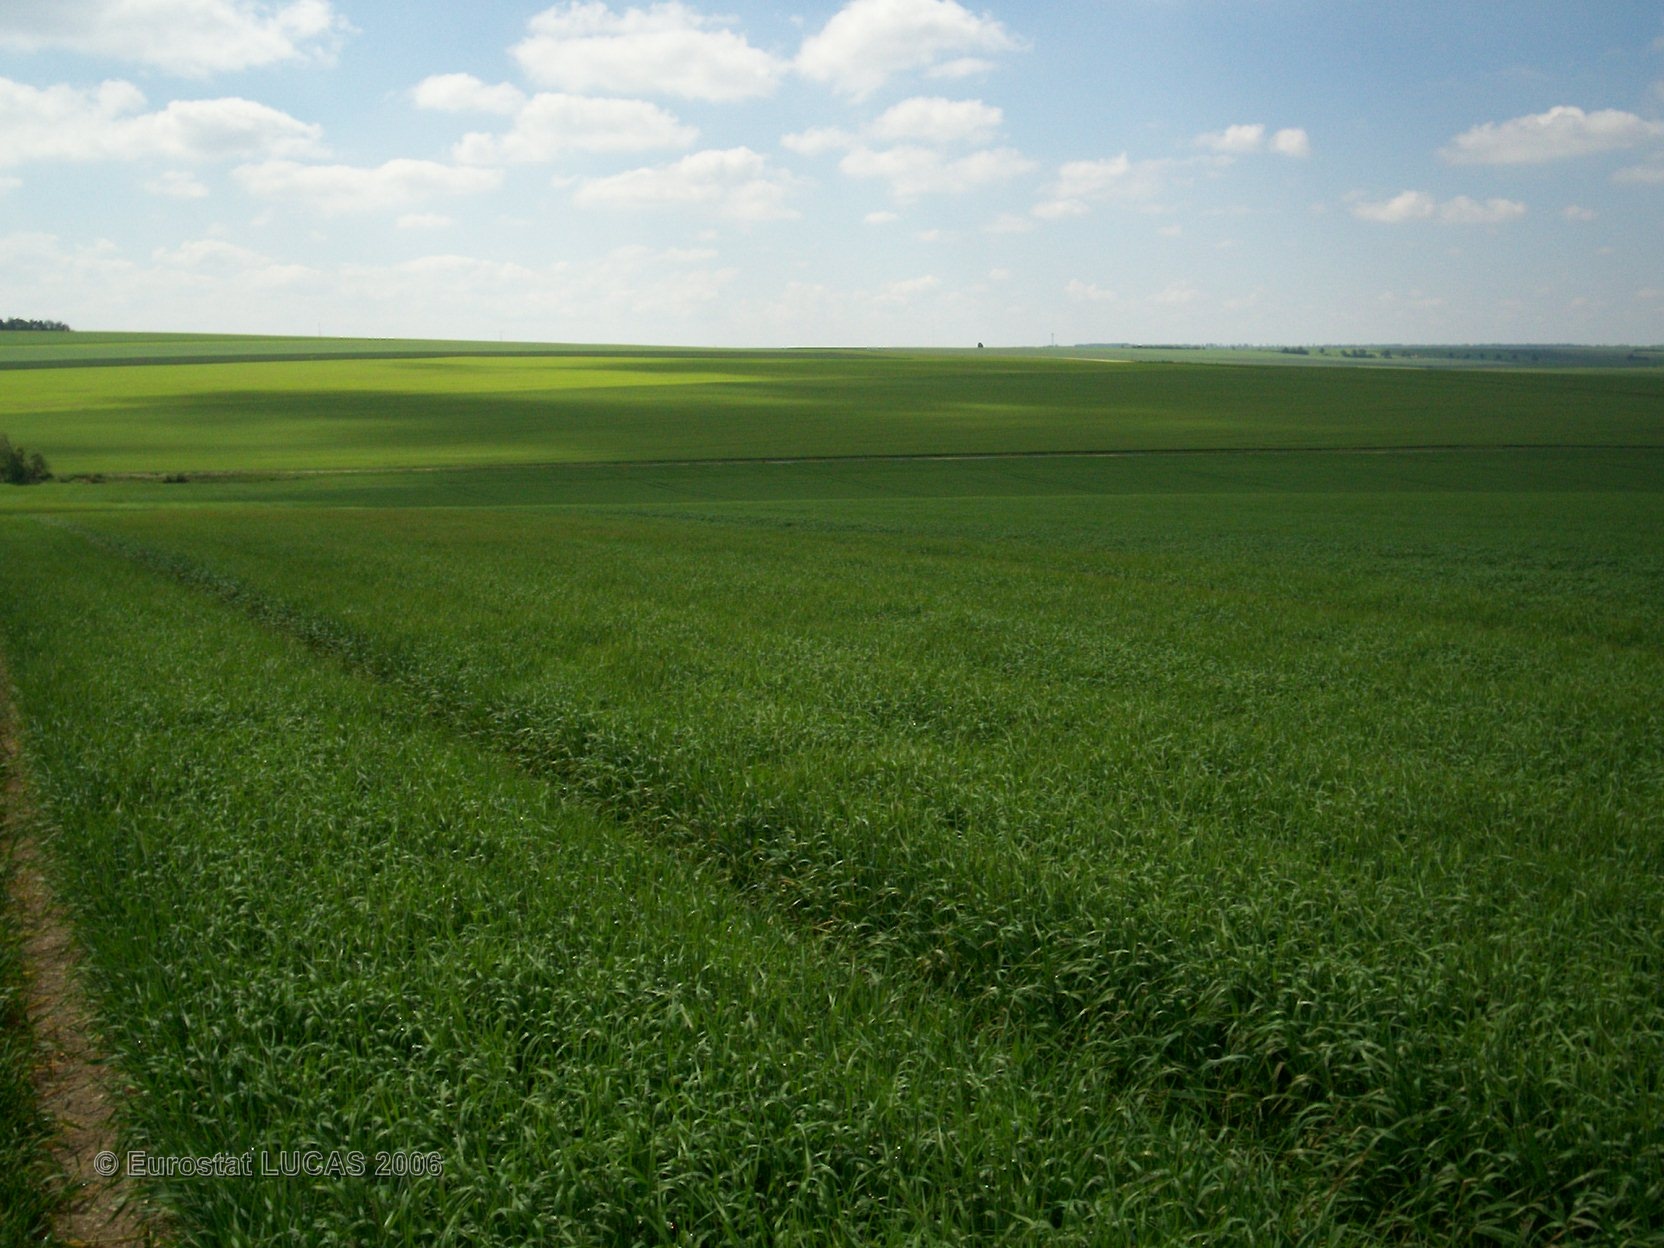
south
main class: Cropland
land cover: Barley
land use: Agriculture (excluding fallow land and kitchen gardens)
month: June
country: FR
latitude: 48.7695
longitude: 4.4591
